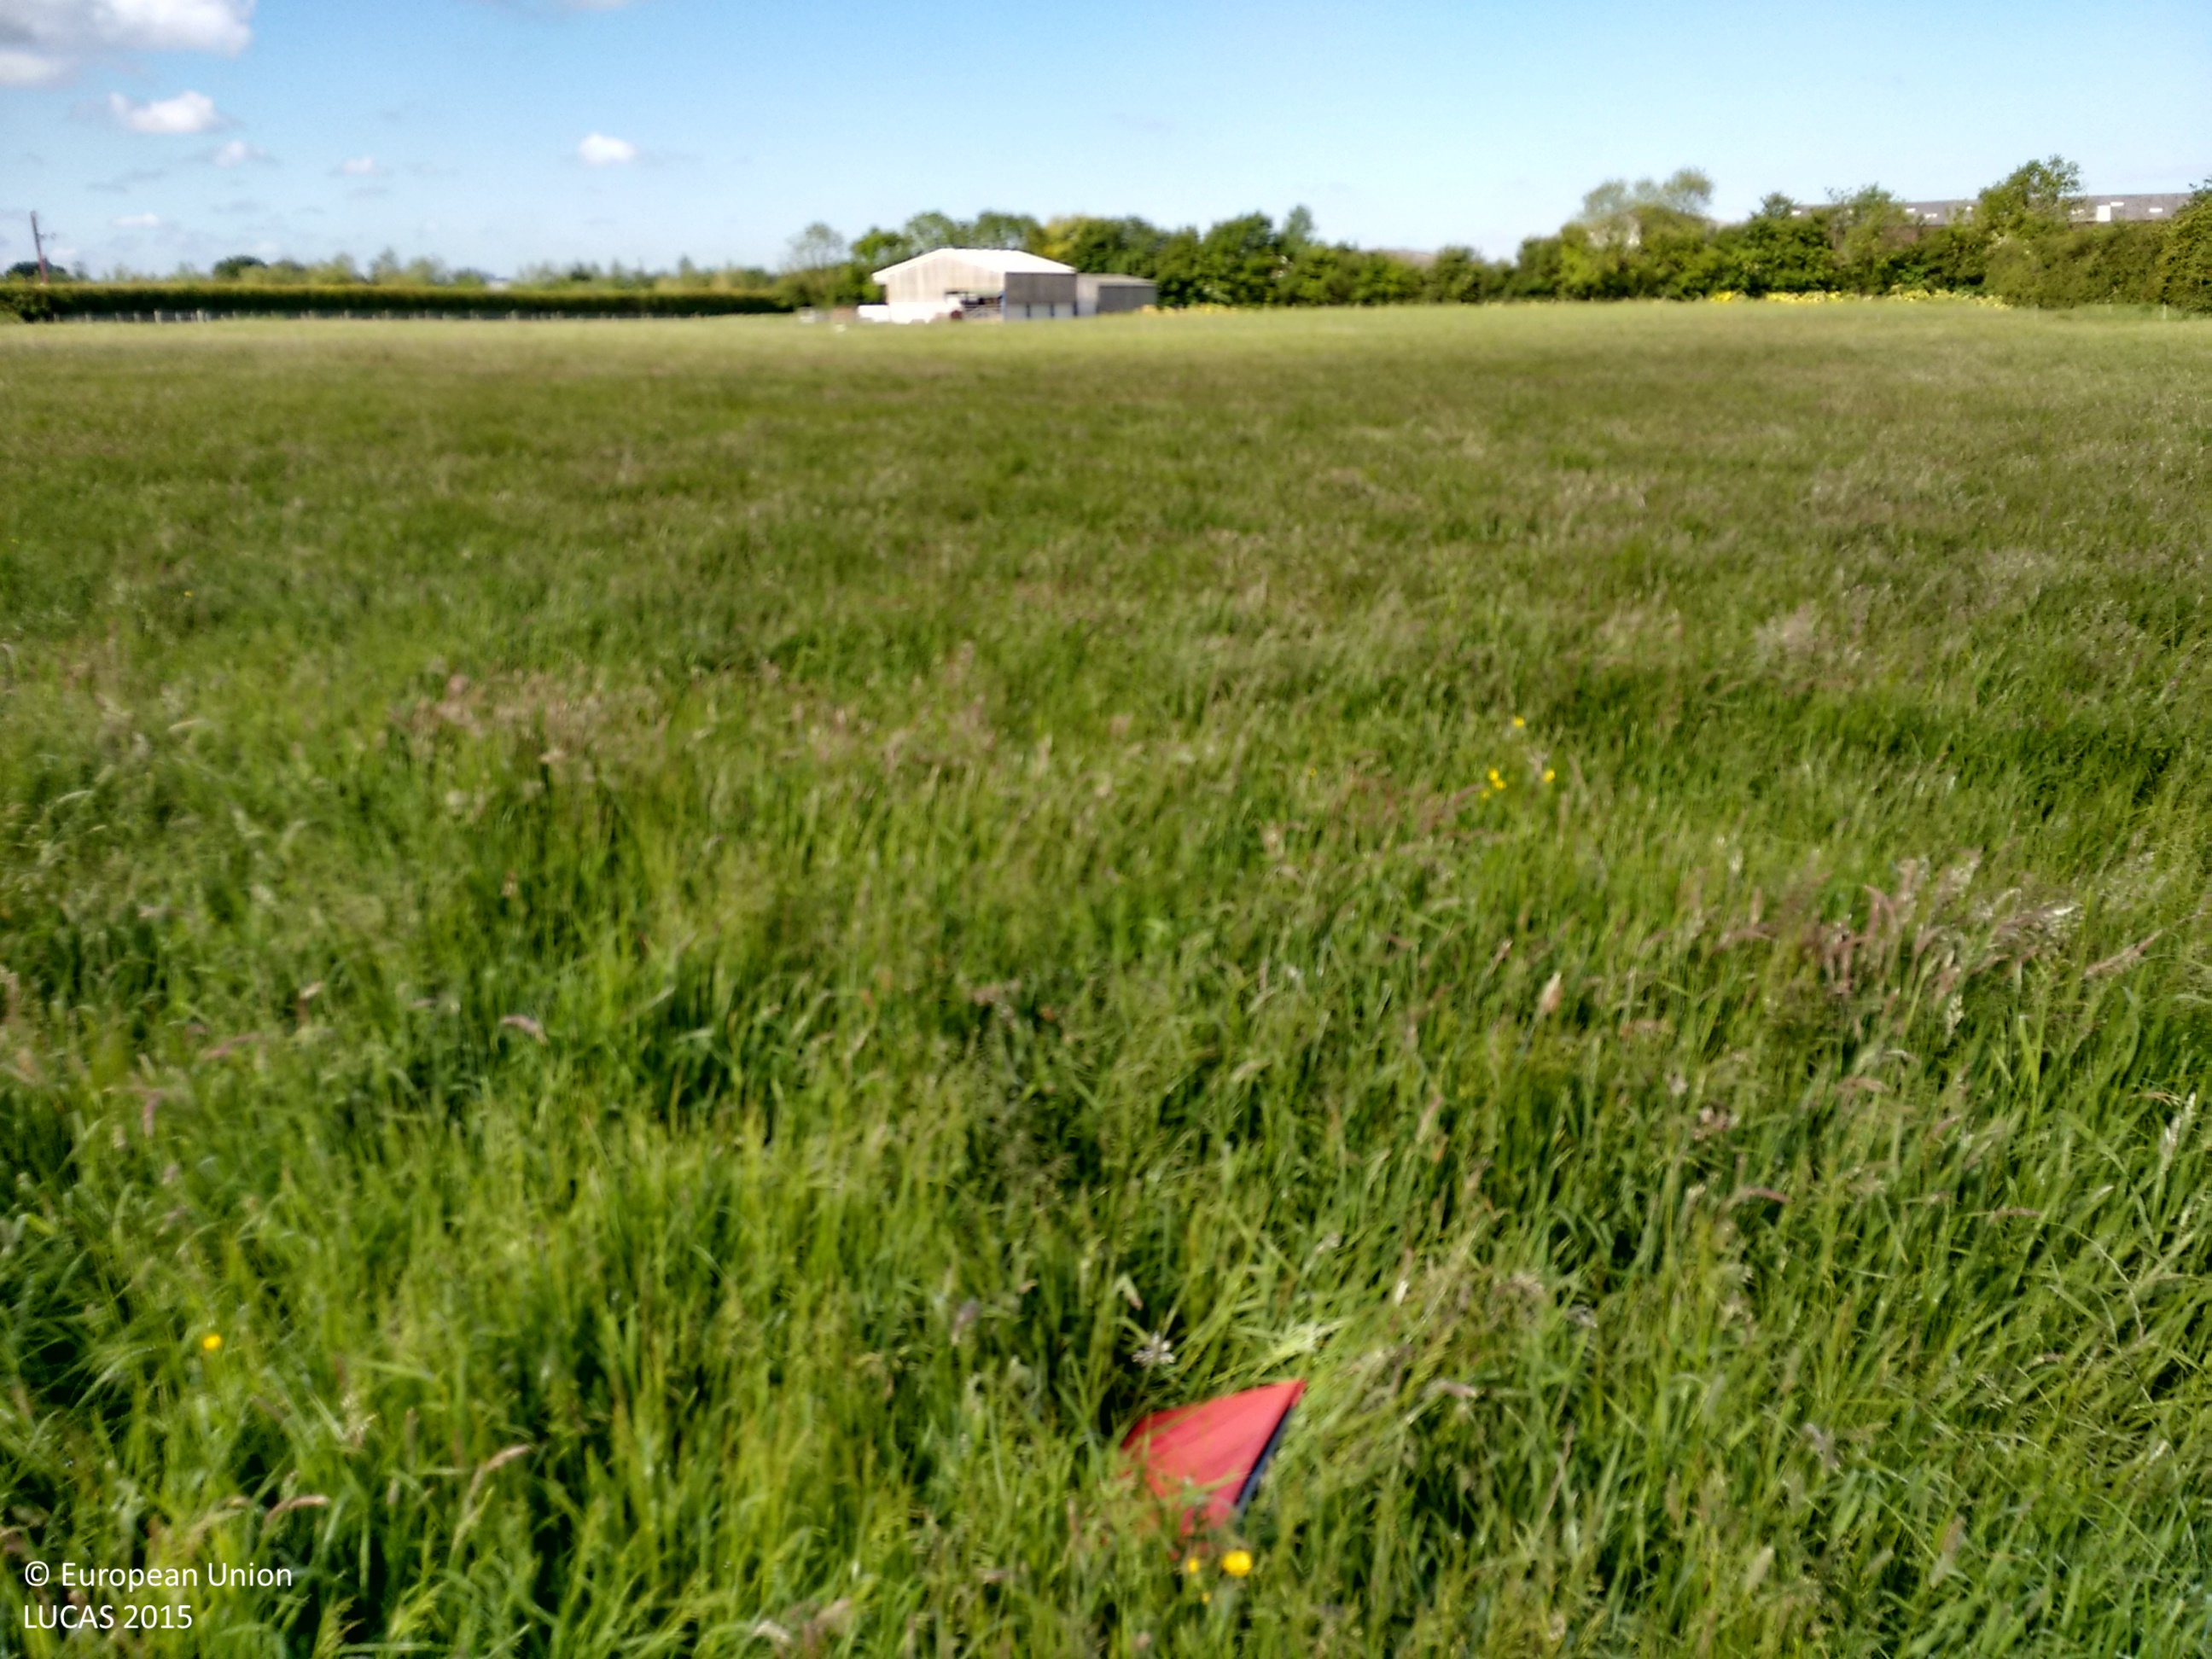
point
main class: Grassland
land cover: Grassland without tree/shrub cover
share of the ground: > 75 %
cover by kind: herbaceous plants 100 %
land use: Agriculture (excluding fallow land and kitchen gardens)
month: June
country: GB
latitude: 54.0802
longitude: -1.1878
